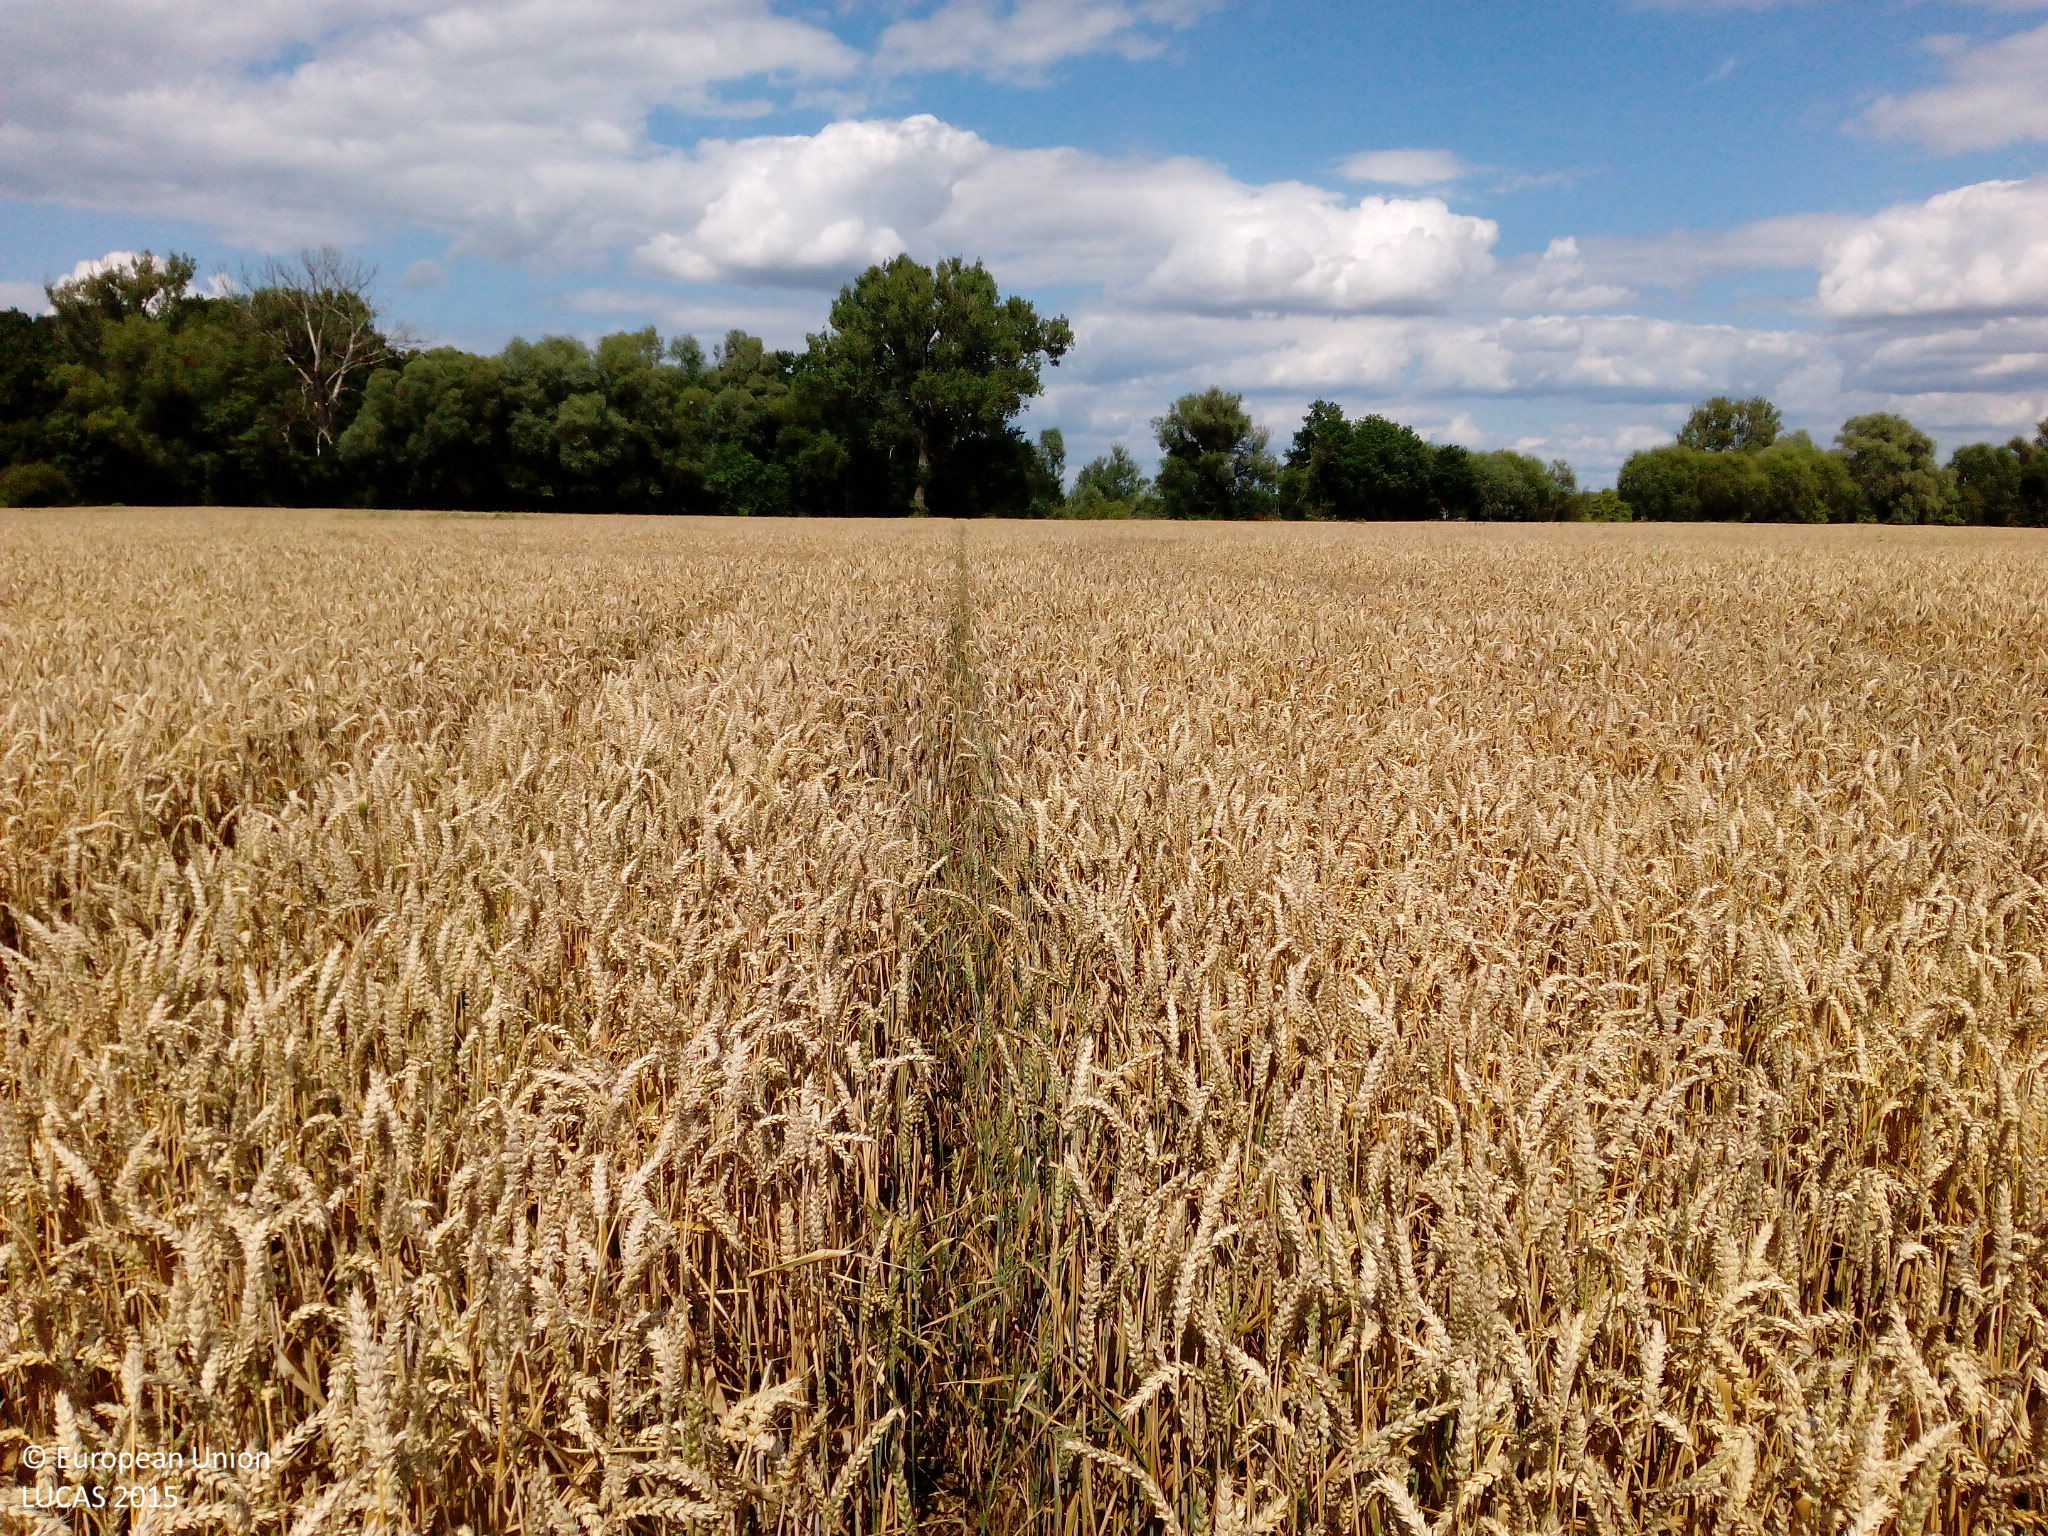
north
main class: Cropland
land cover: Common wheat
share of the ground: > 75 %
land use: Agriculture (excluding fallow land and kitchen gardens)
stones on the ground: < 10 %
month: July
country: DE
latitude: 52.6541
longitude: 14.4510
